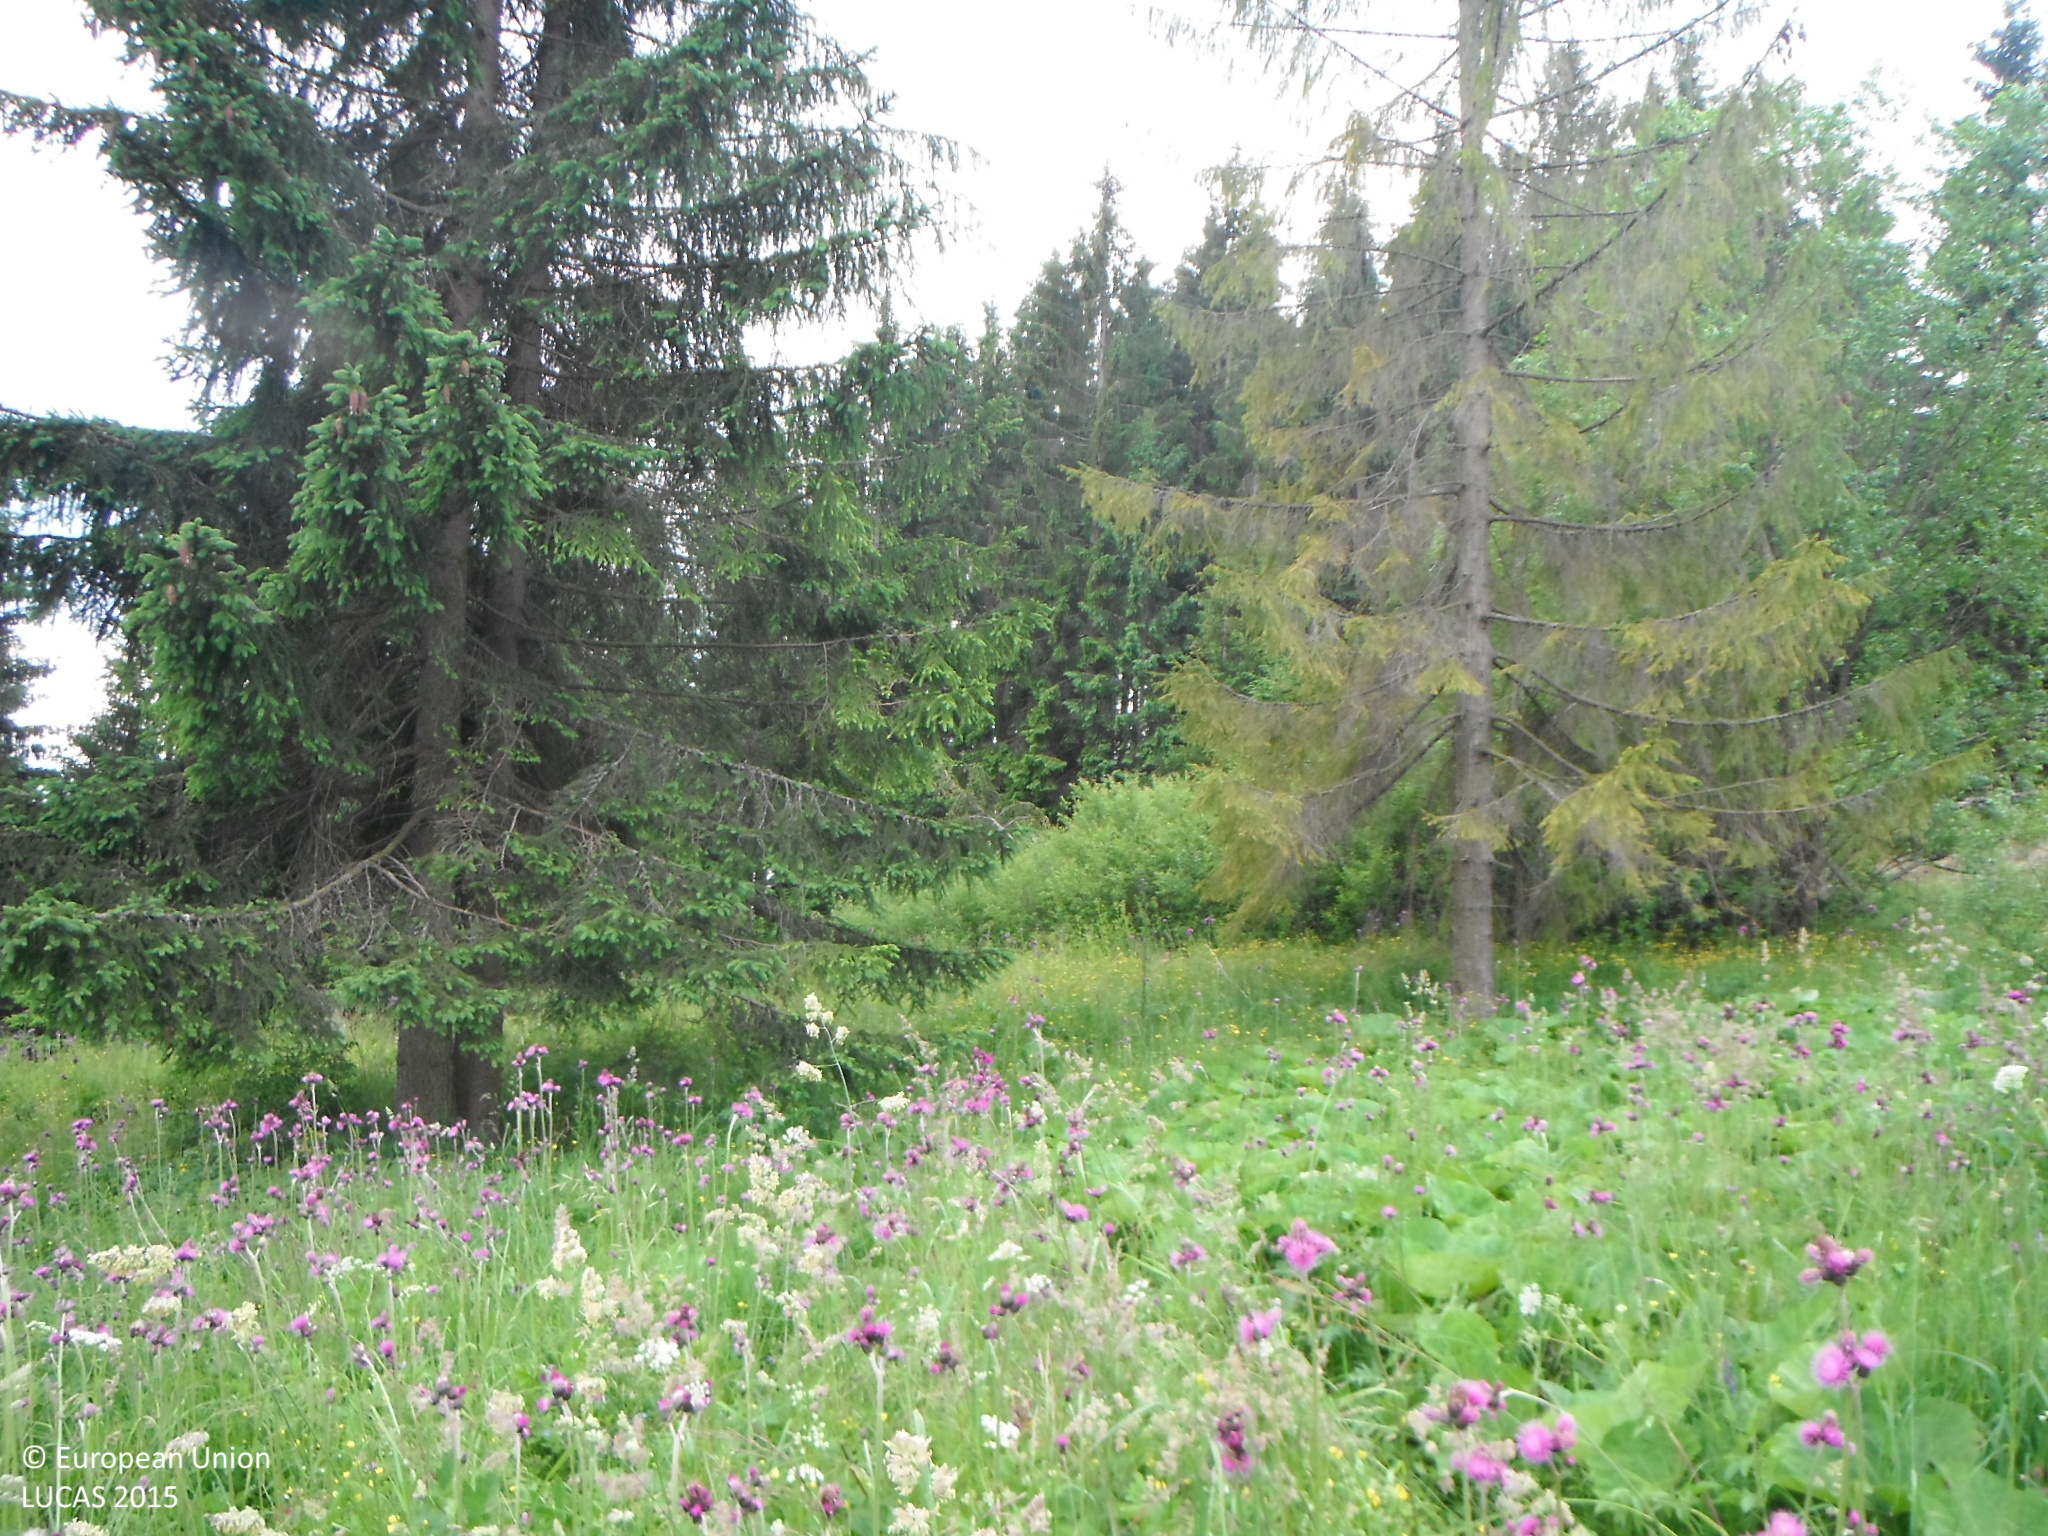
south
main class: Grassland
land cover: Spontaneously vegetated surfaces
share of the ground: > 75 %
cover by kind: herbaceous plants 100 %
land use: Semi-natural and natural areas not in use
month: July
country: SK
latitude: 49.4431
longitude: 19.2790
